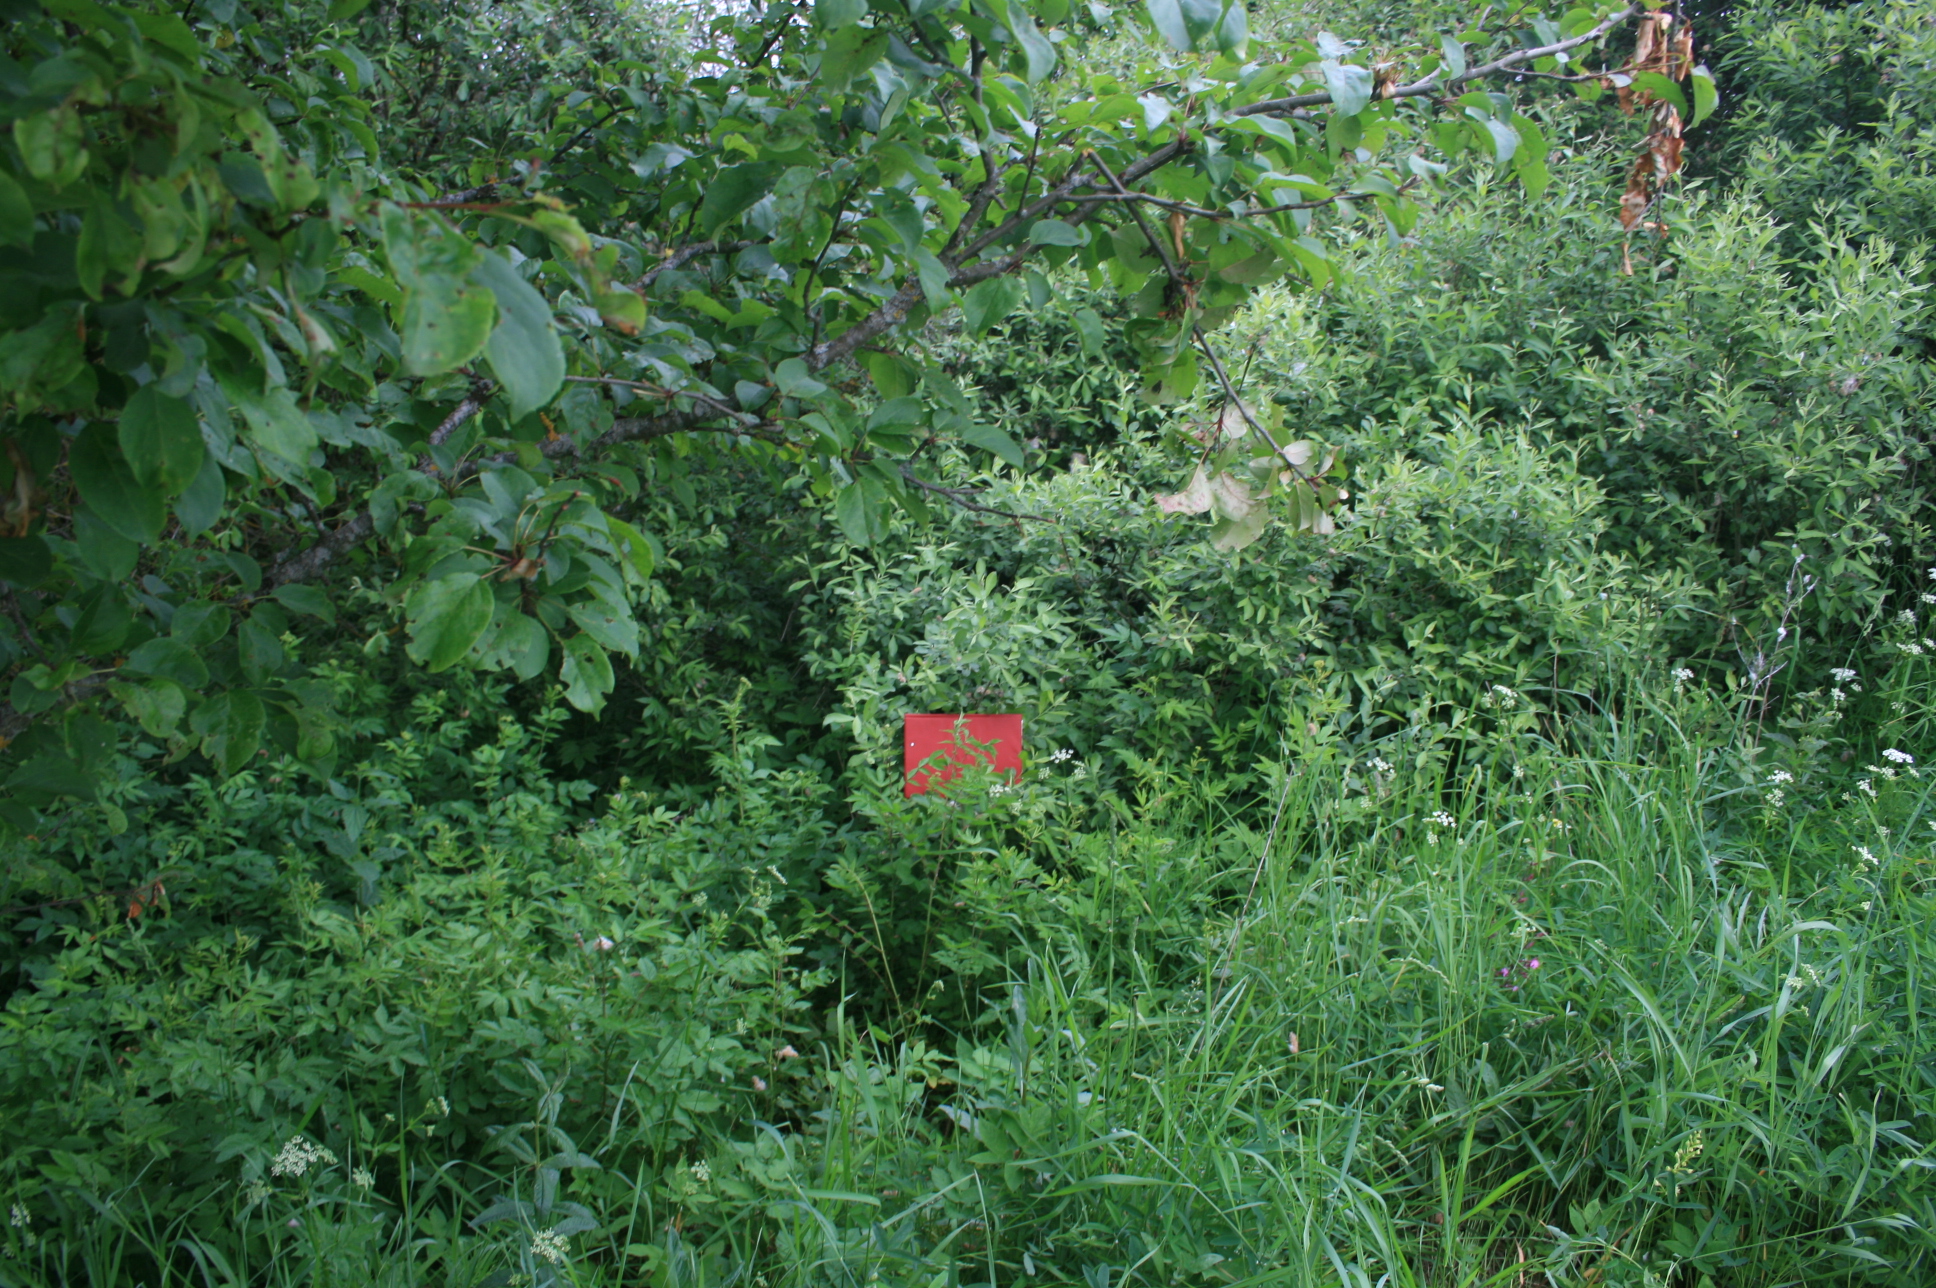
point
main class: Woodland
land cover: Broadleaved woodland
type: non-riverine alder, birch or aspen forest
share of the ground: > 75 %
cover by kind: broadleaved forest trees 90 %, herbaceous plants 10 %
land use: Semi-natural and natural areas not in use
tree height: > 5 m
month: June
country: LT
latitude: 55.7062
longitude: 22.2625
